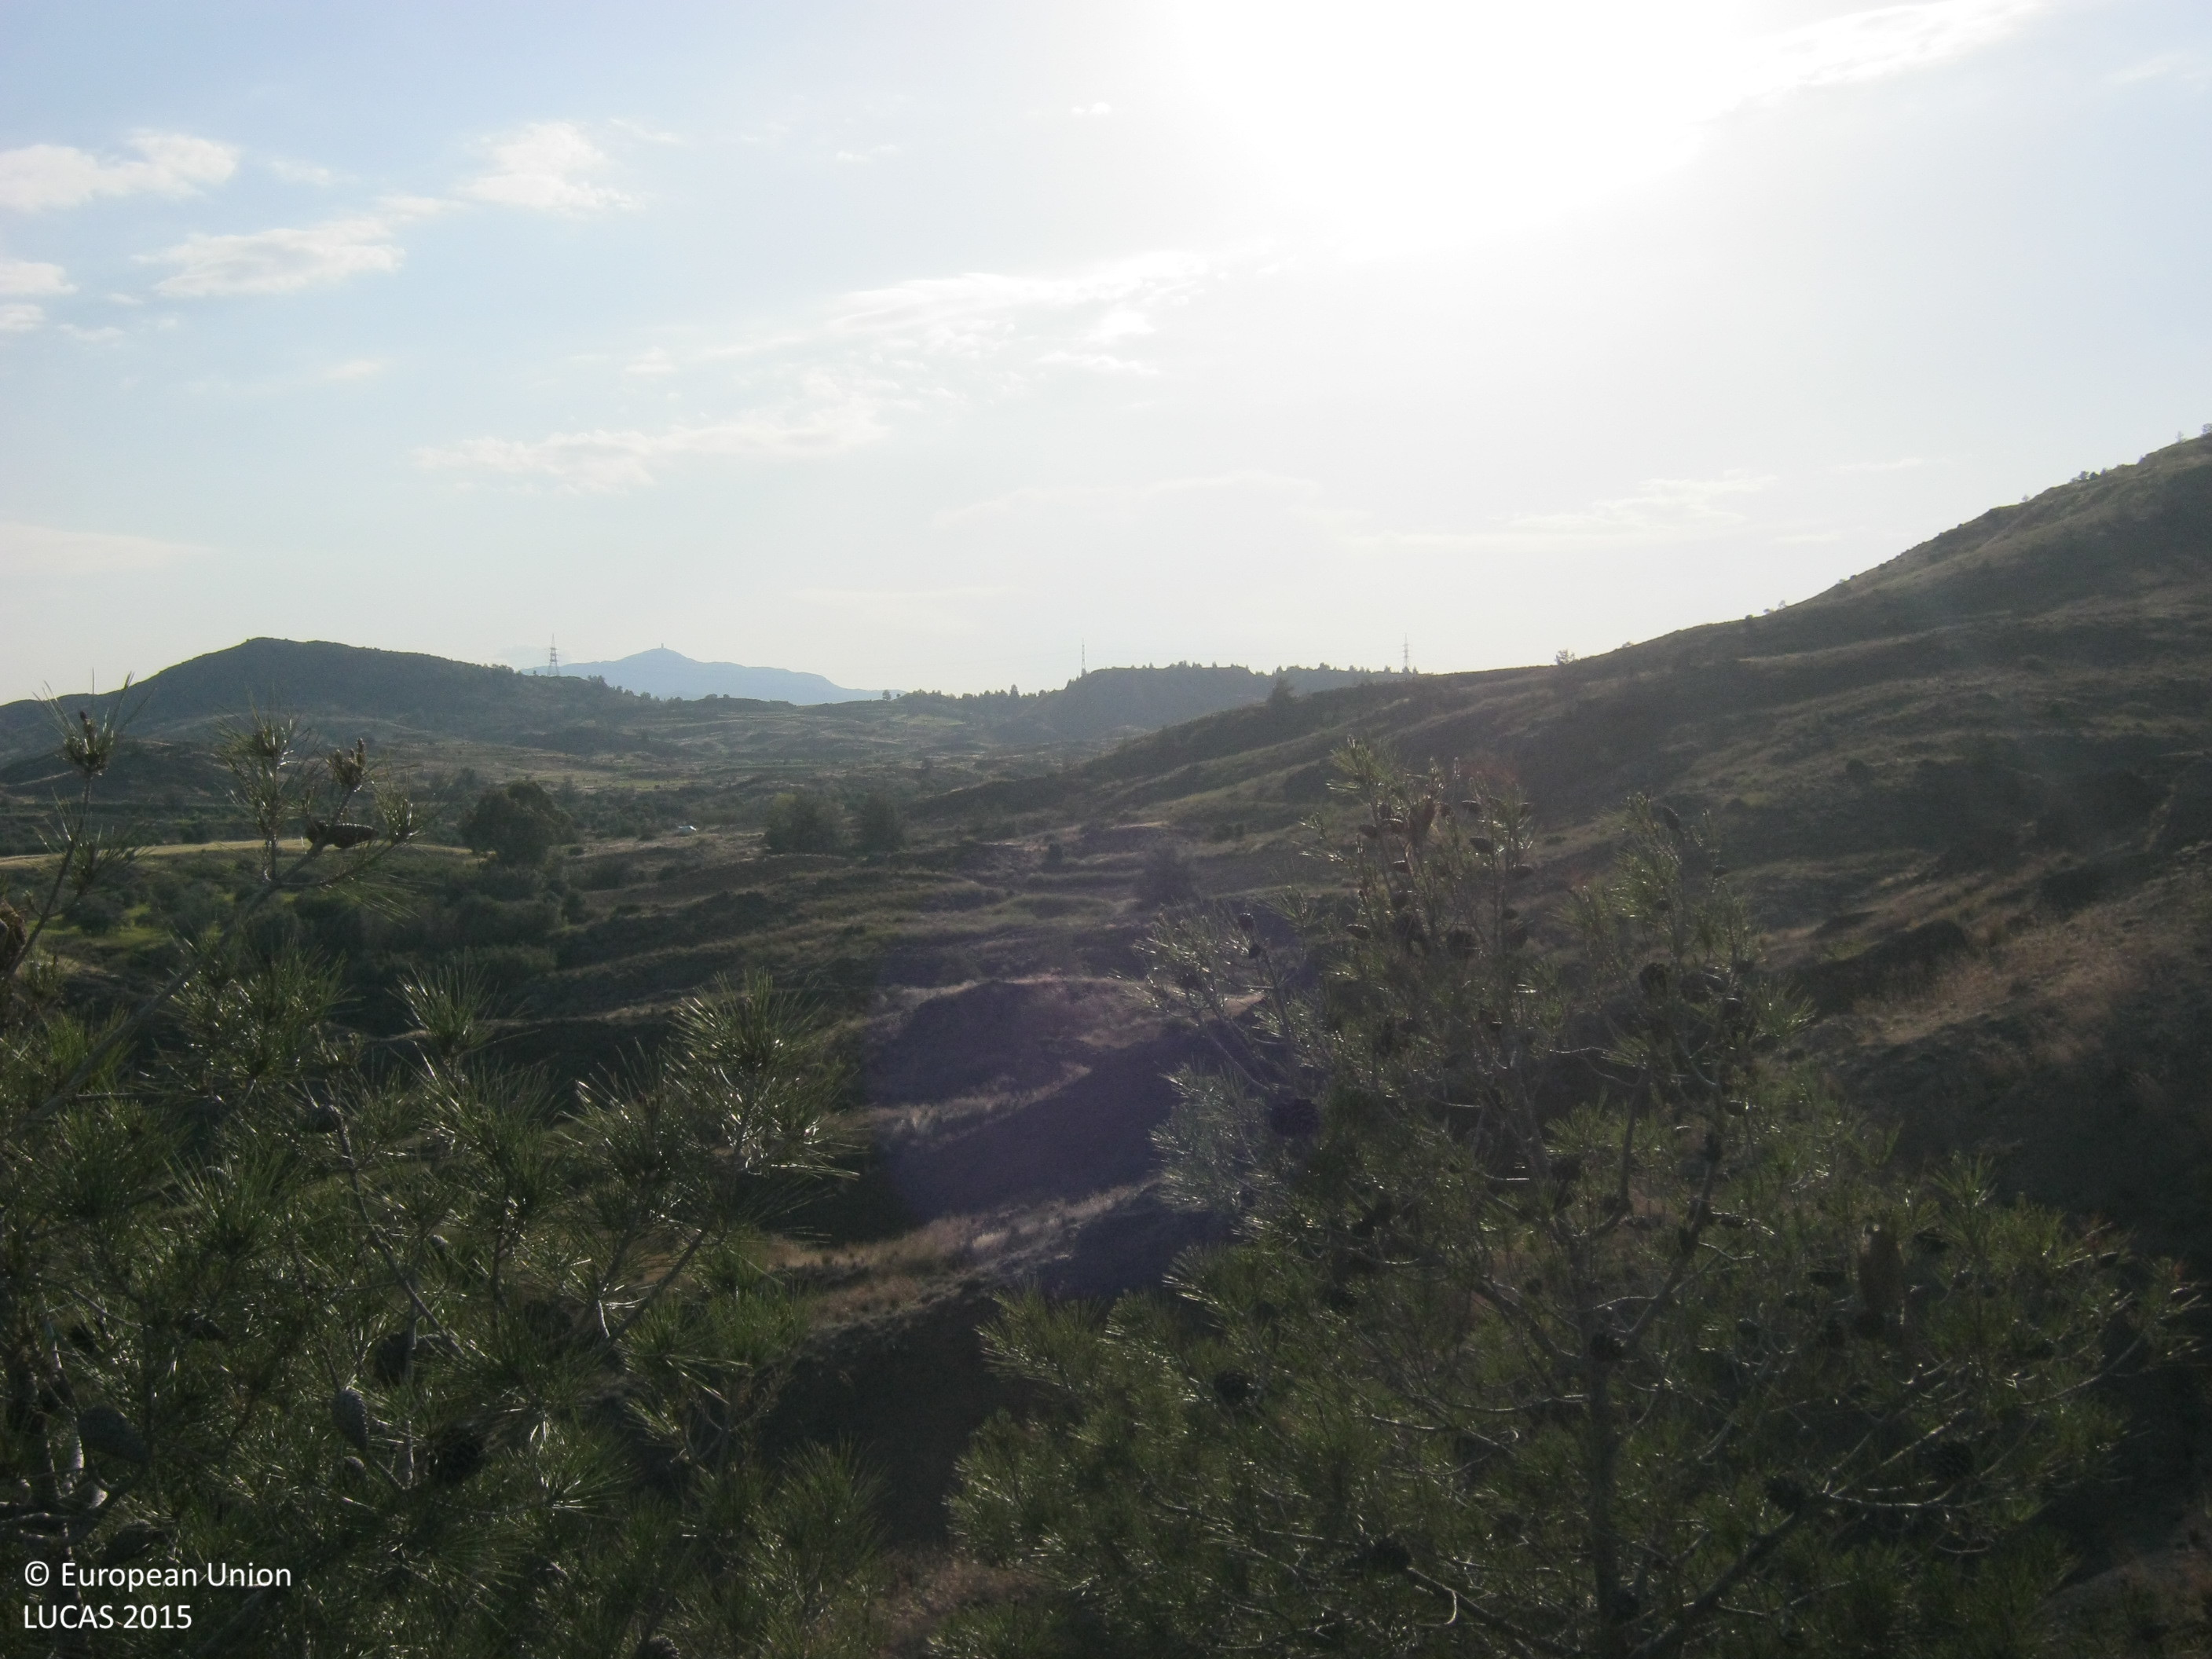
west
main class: Shrubland
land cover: Shrubland without tree cover
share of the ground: 25 - 50 %
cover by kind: unconsolidated bare surface 30 %, shrubs 25 %, herbaceous plants 25 %, consolidated bare surface 20 %
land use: Semi-natural and natural areas not in use
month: April
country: CY
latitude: 34.9781
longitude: 33.3775
